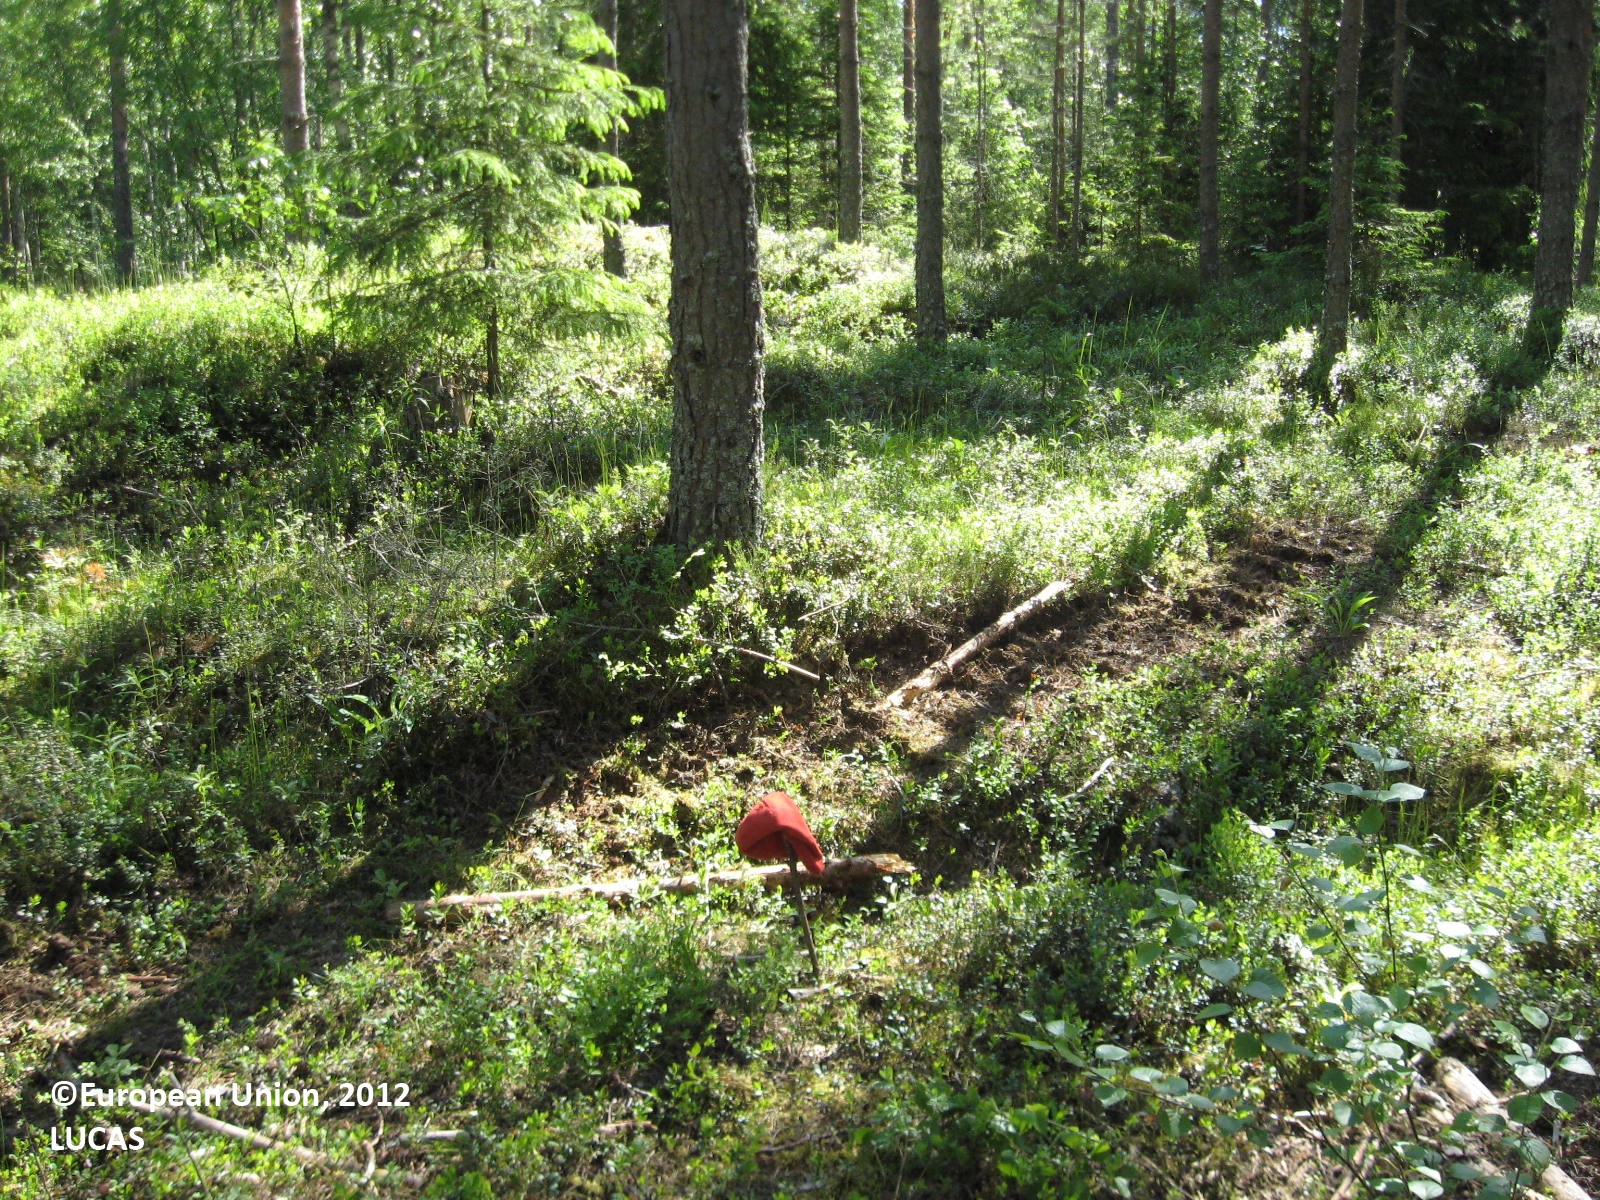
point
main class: Woodland
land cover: Pine dominated coniferous woodland
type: boreal forest
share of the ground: > 75 %
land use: Forestry
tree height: > 5 m
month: June
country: FI
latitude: 62.8317
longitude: 21.6839
